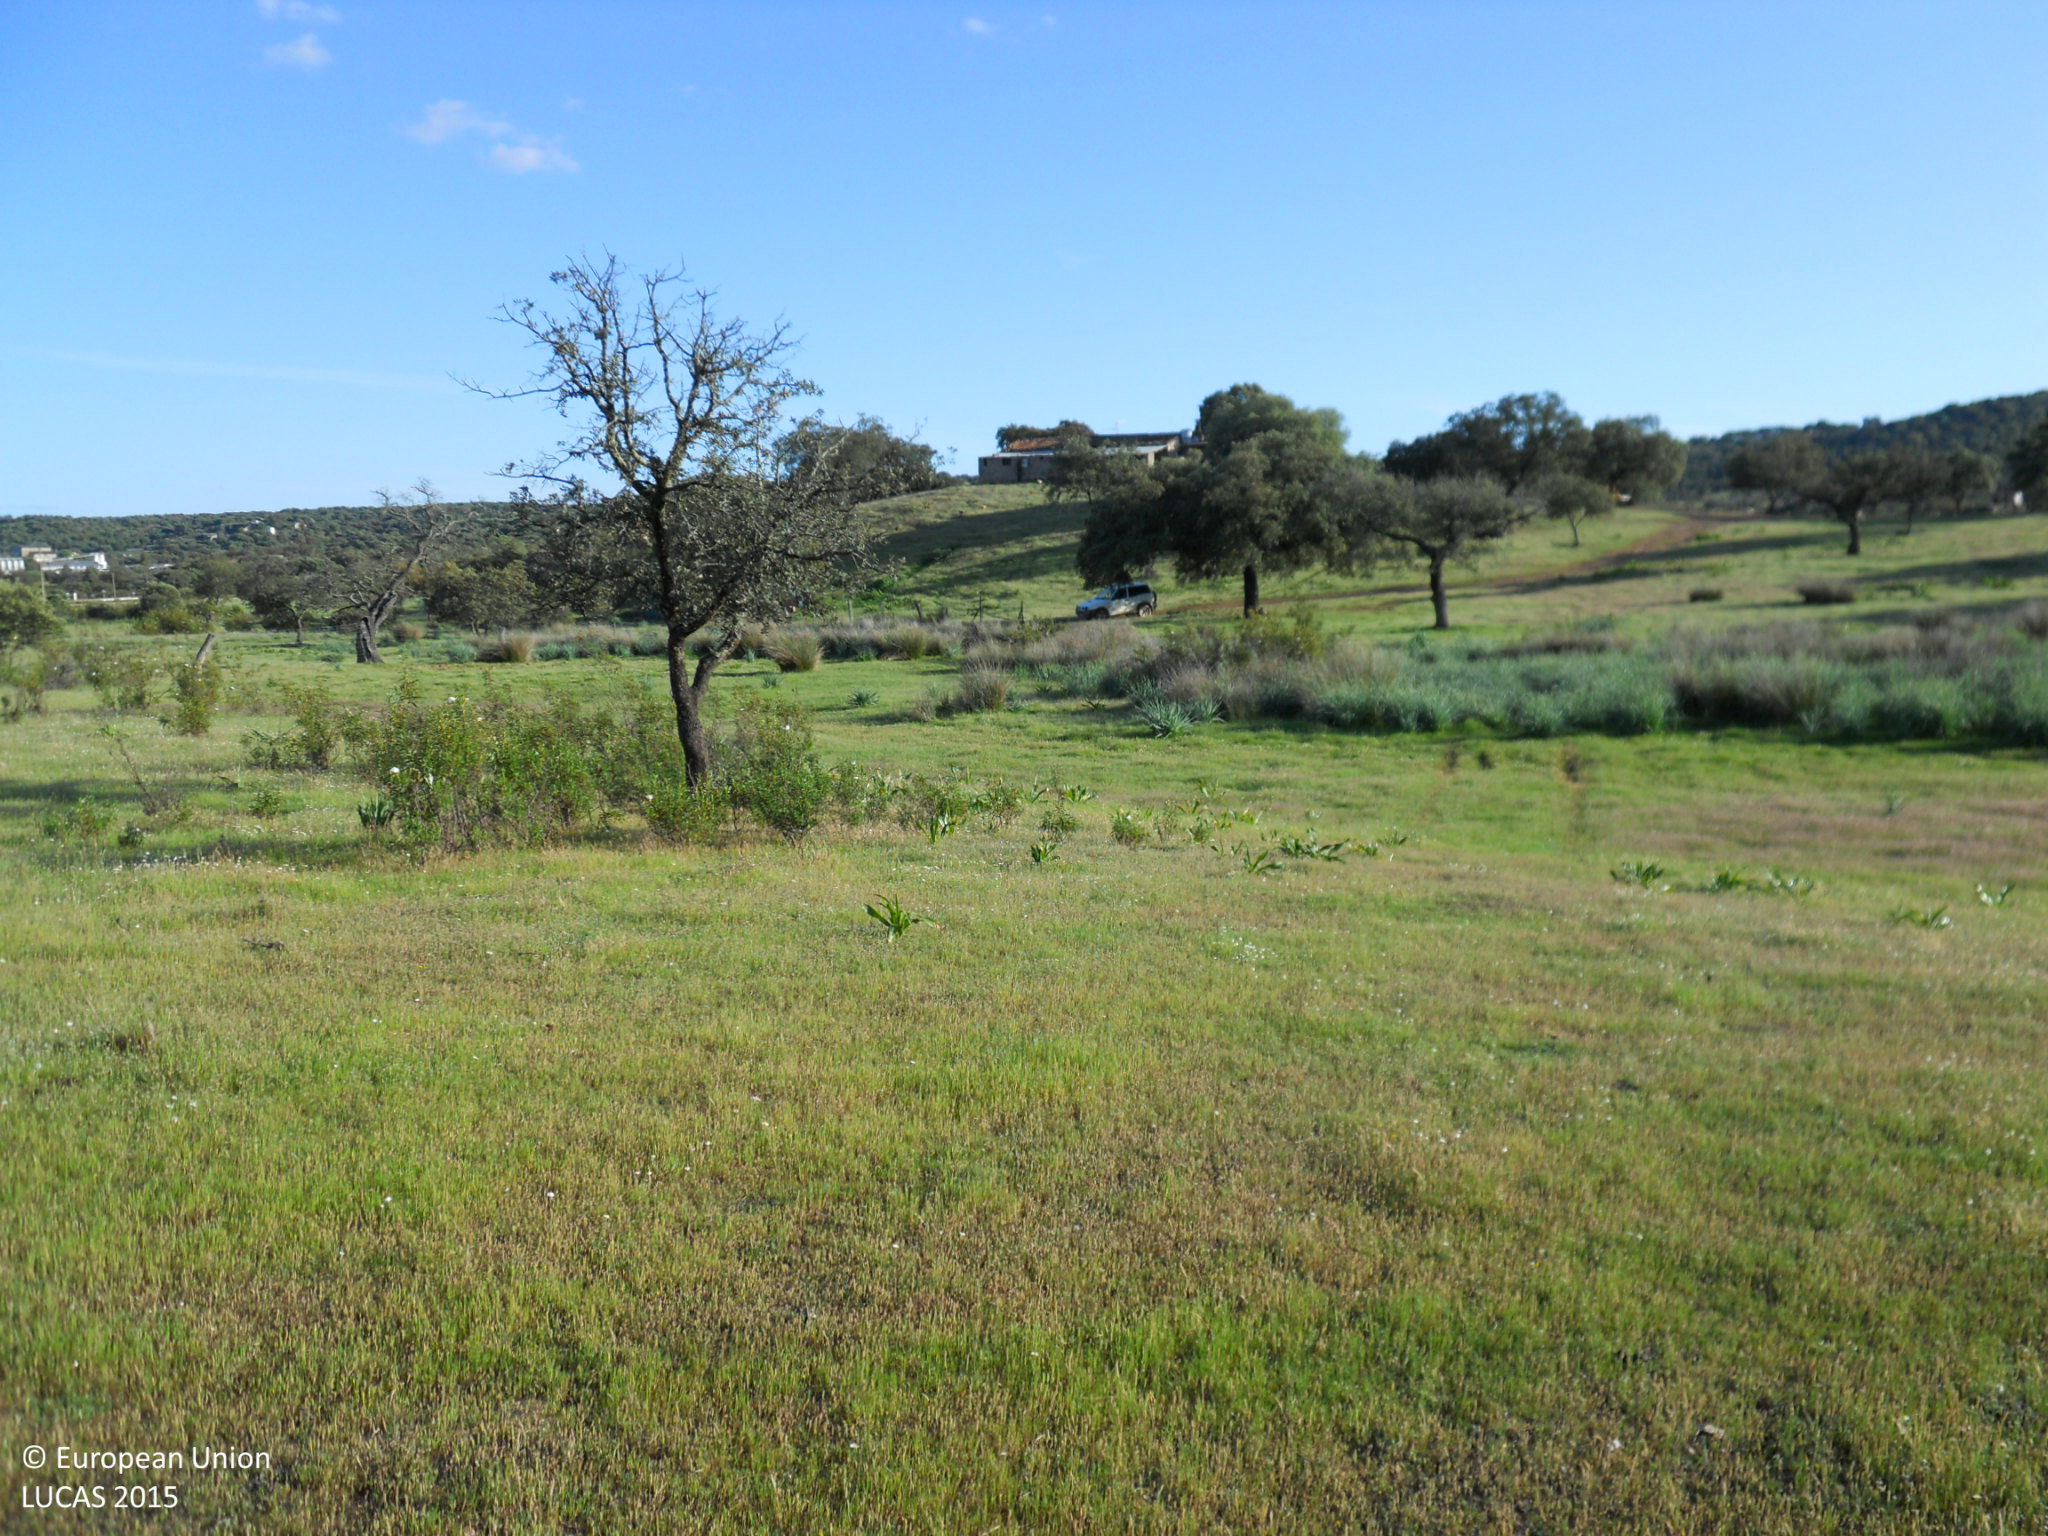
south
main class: Grassland
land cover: Grassland with sparse tree/shrub cover
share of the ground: > 75 %
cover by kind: herbaceous plants 90 %, broadleaved forest trees 5 %, shrubs 5 %
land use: Agriculture (excluding fallow land and kitchen gardens)
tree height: > 5 m
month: April
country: ES
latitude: 39.1984
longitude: -7.0879
